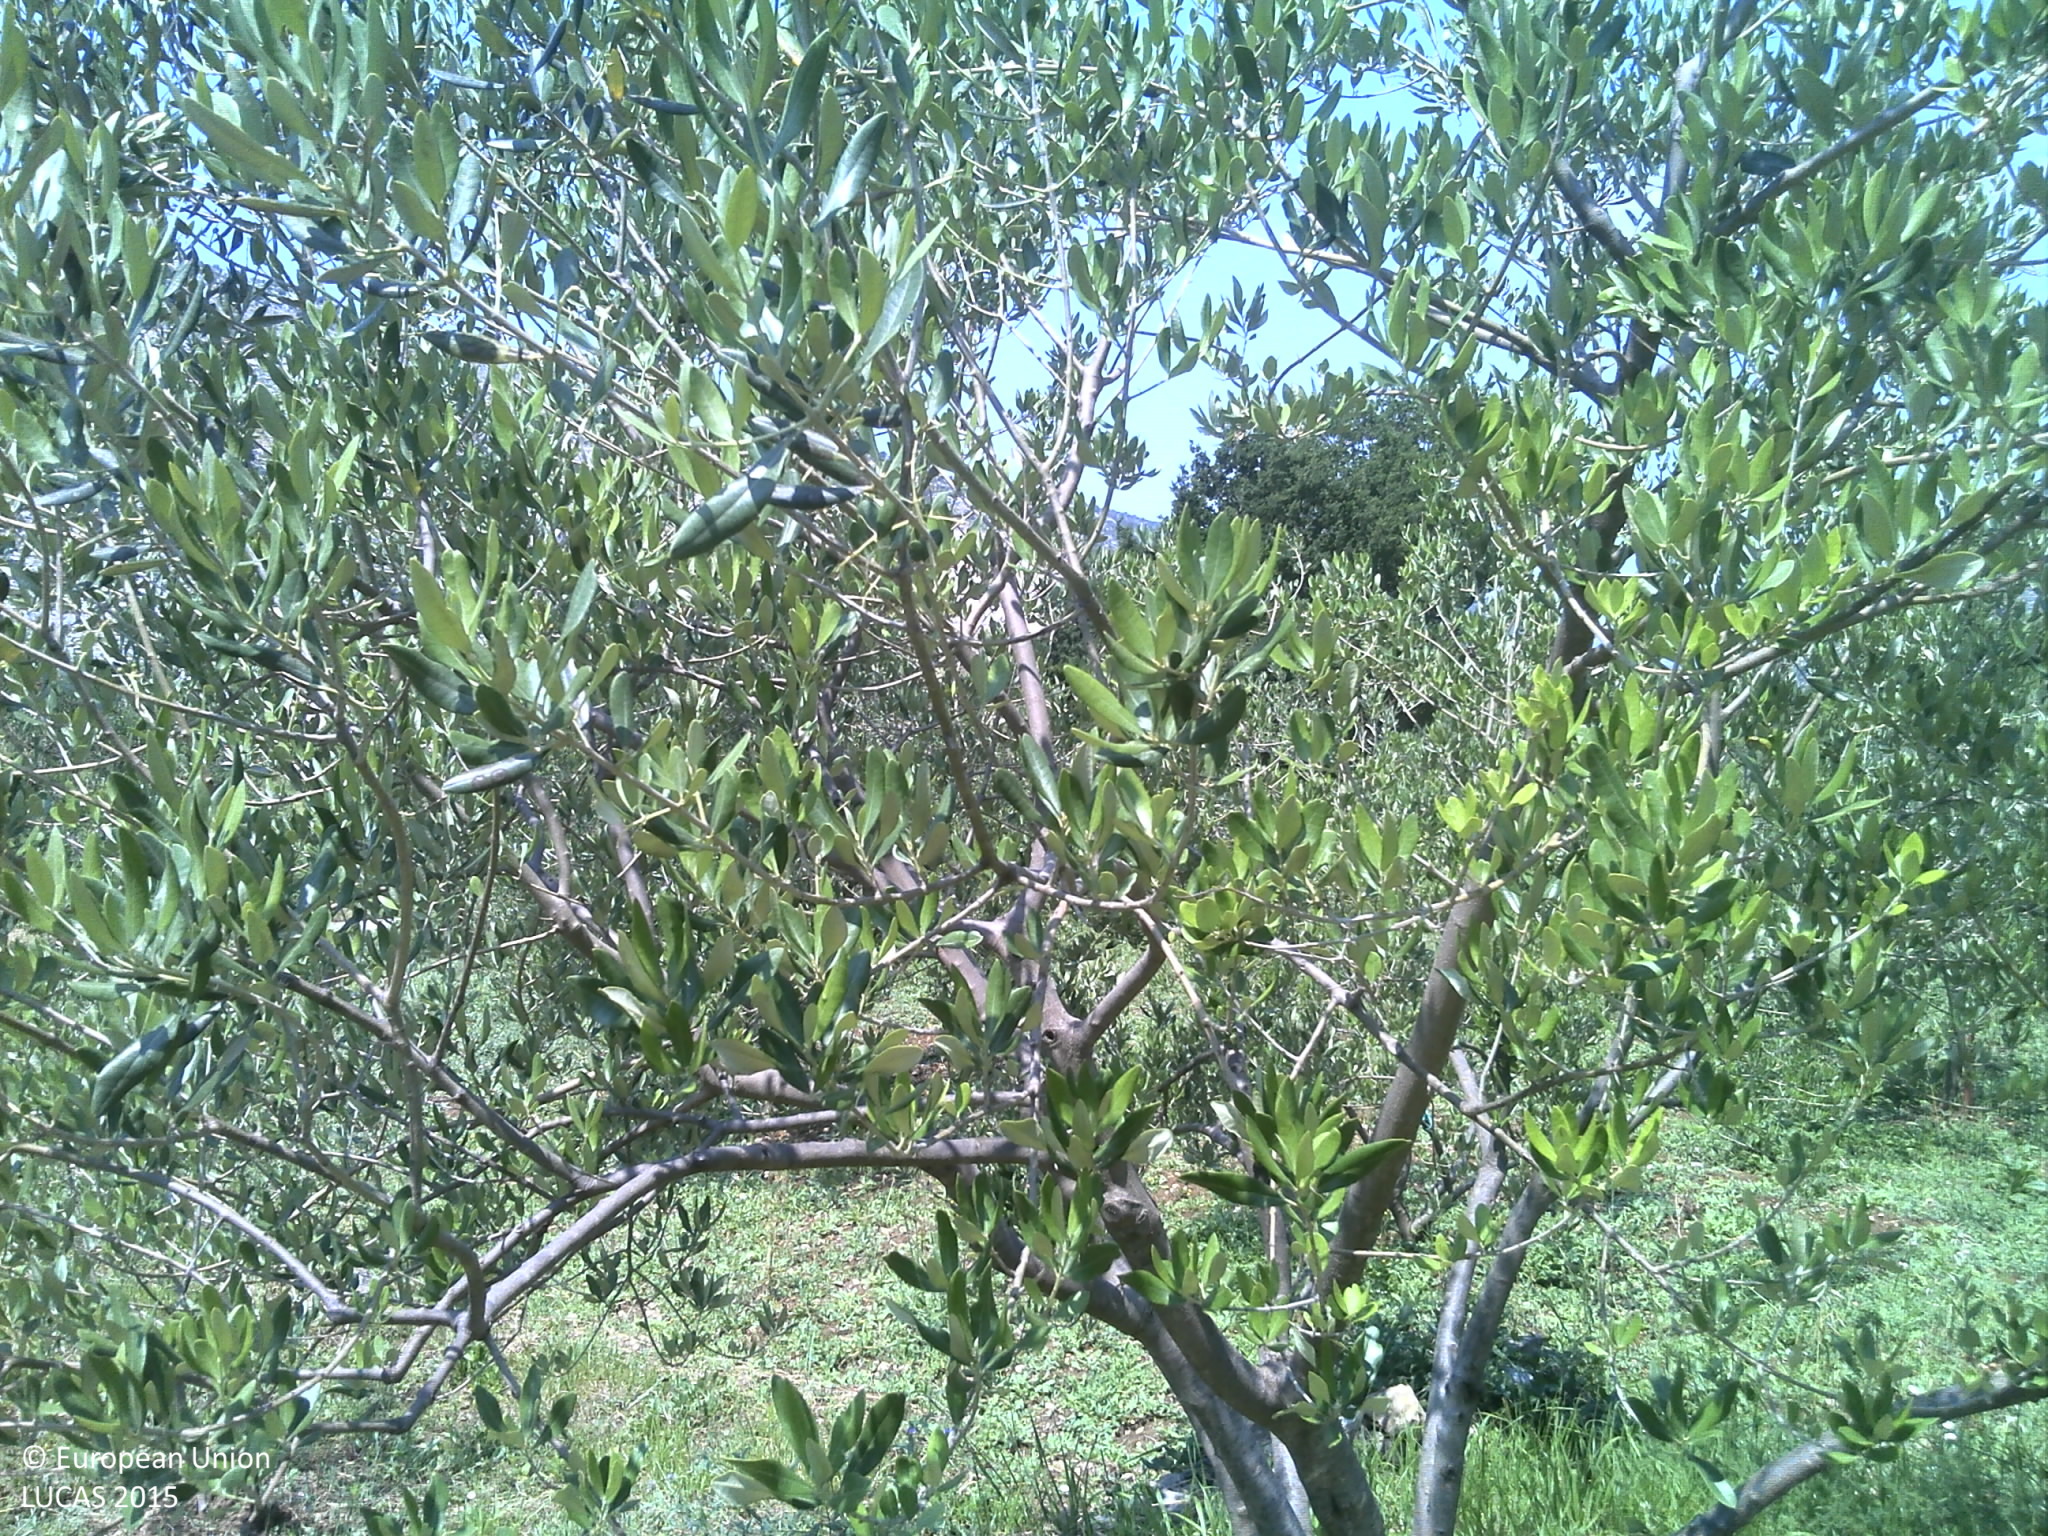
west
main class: Grassland
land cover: Grassland with sparse tree/shrub cover
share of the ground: > 75 %
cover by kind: herbaceous plants 85 %, shrubs 10 %, broadleaved forest trees 5 %
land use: Agriculture (excluding fallow land and kitchen gardens)
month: June
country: HR
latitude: 43.4885
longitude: 16.6063
